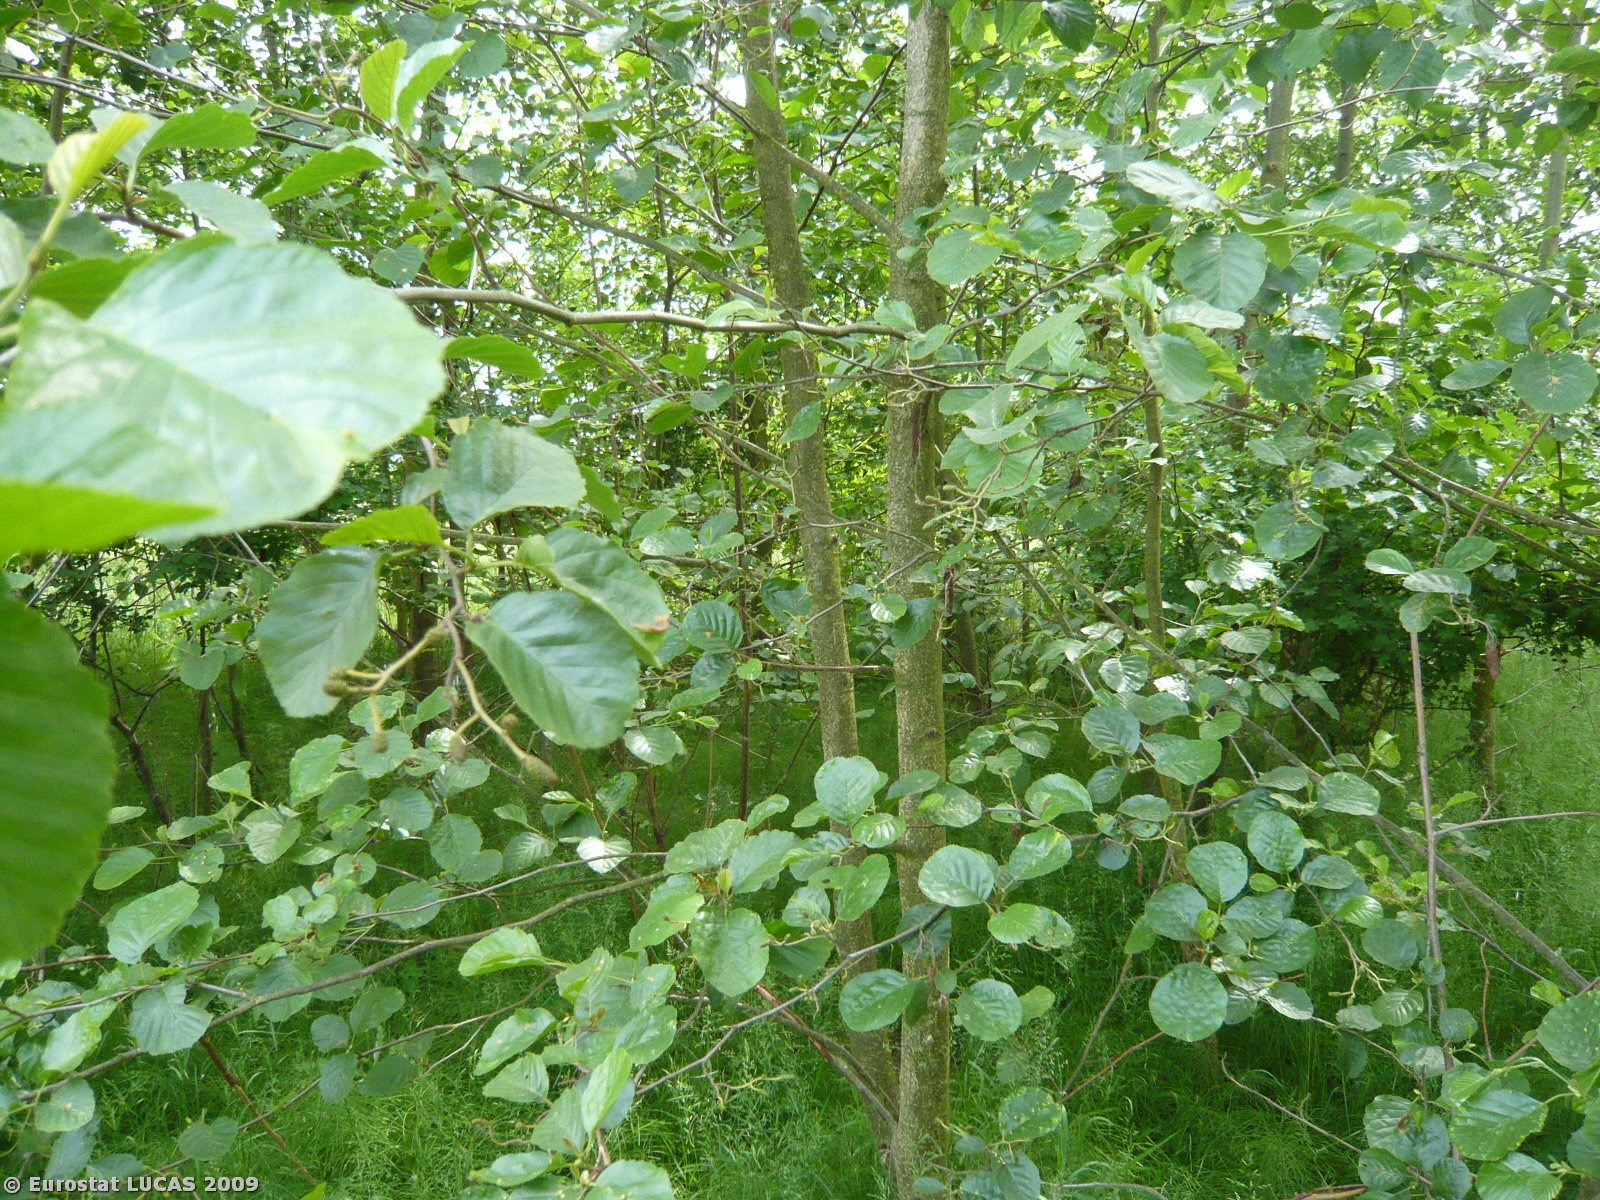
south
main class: Woodland
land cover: Broadleaved woodland
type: mire and swamp forests
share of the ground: > 75 %
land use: Unused
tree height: > 5 m
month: June
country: DK
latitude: 55.2456
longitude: 11.3673
